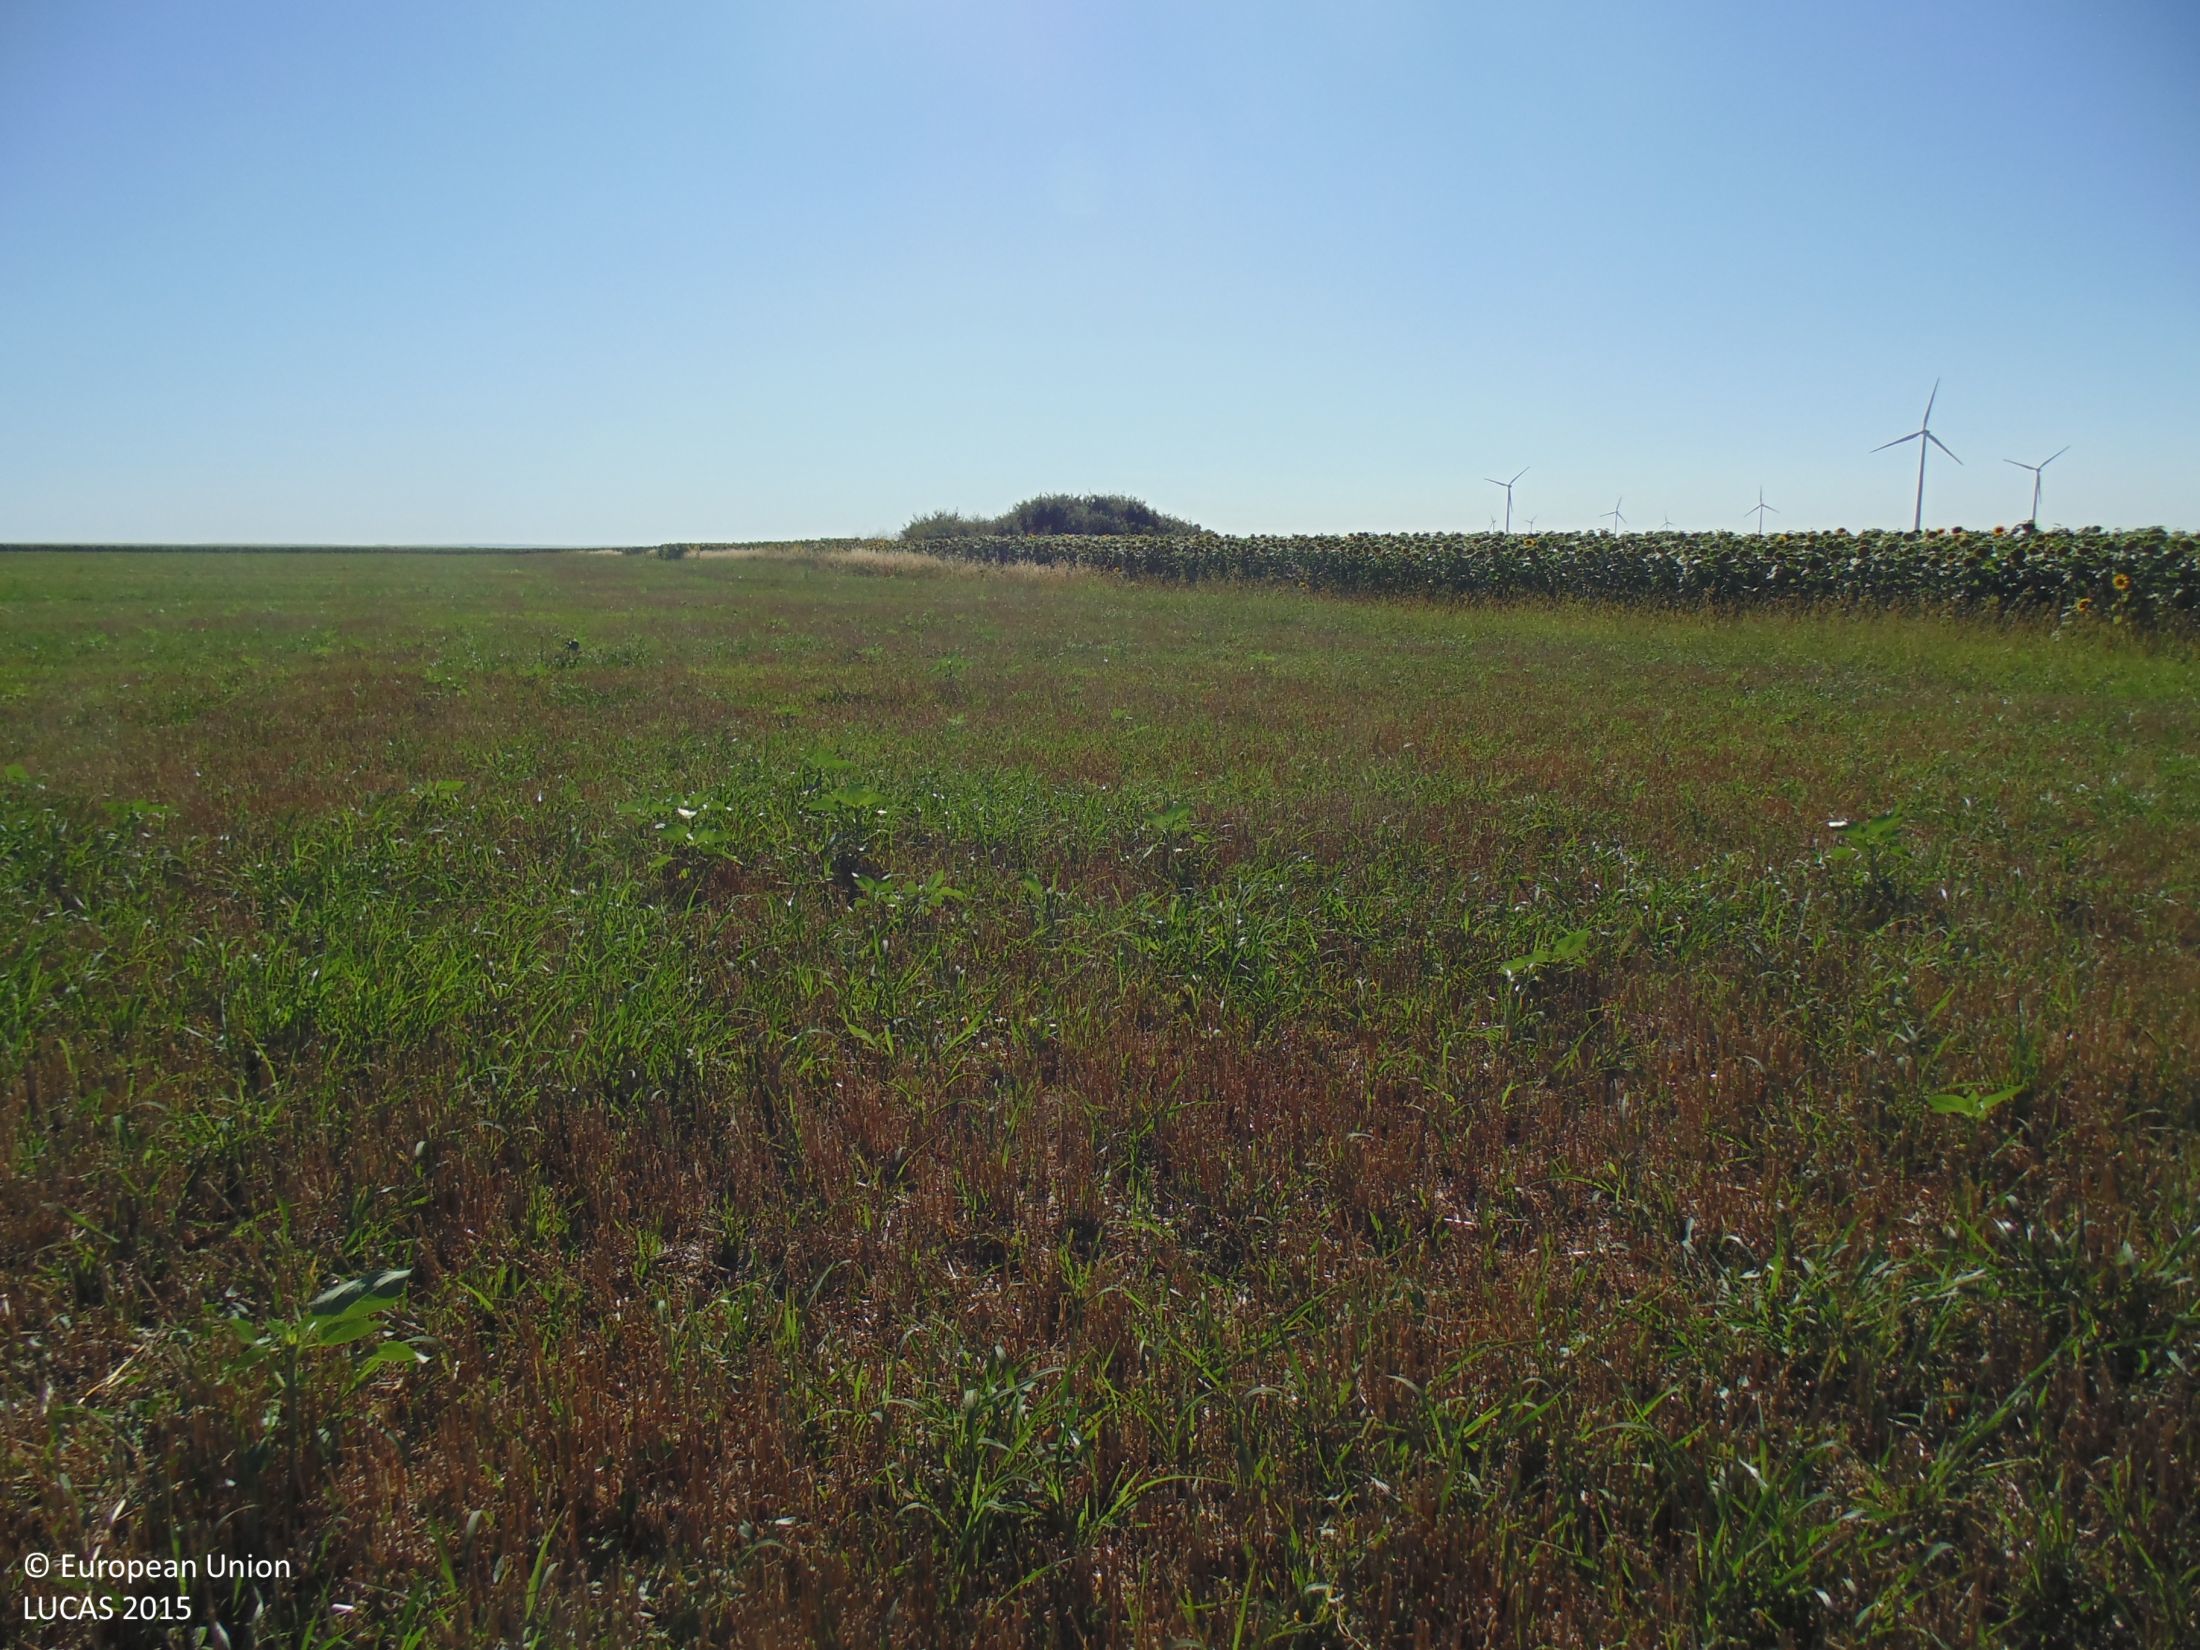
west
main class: Cropland
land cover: Barley
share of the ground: 10 - 25 %
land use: Agriculture (excluding fallow land and kitchen gardens)
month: July
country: BG
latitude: 43.4303
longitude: 28.0714
